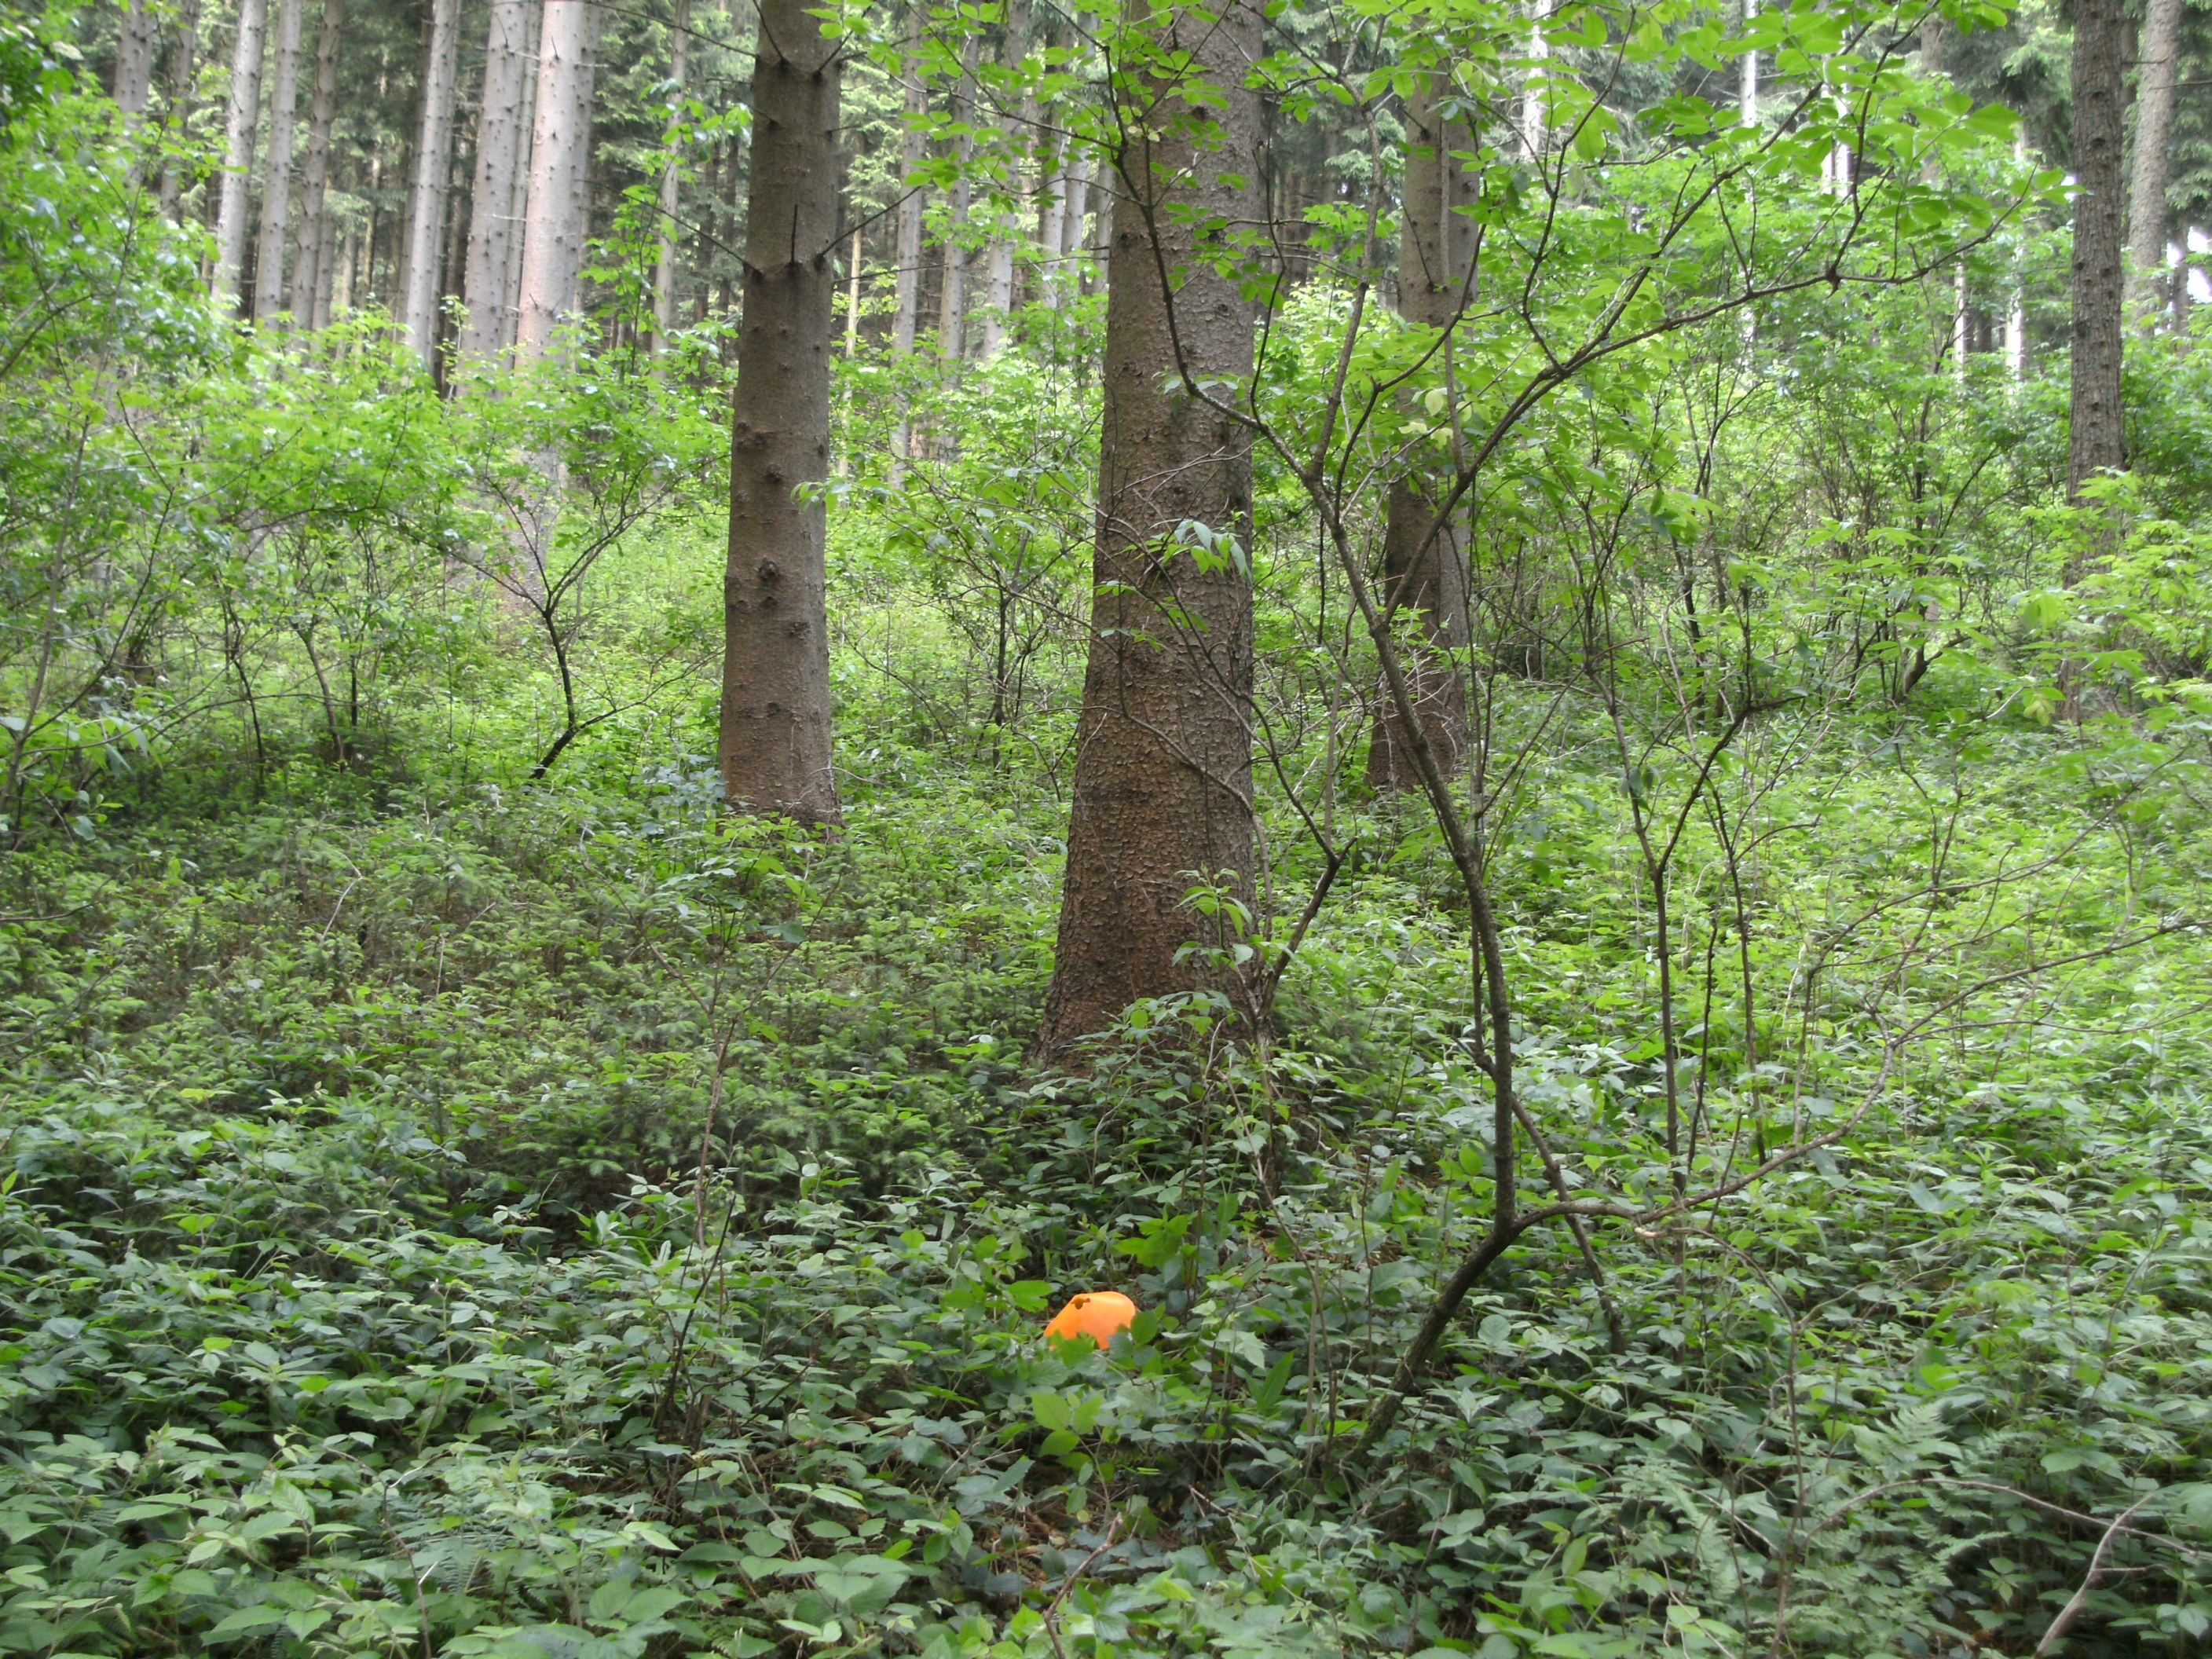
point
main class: Woodland
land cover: Spruce dominated coniferous woodland
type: alpine coniferous forest
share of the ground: > 75 %
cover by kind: coniferous forest trees 80 %, shrubs 15 %, herbaceous plants 5 %
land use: Forestry
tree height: > 5 m
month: June
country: AT
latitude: 48.5046
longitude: 14.1825
